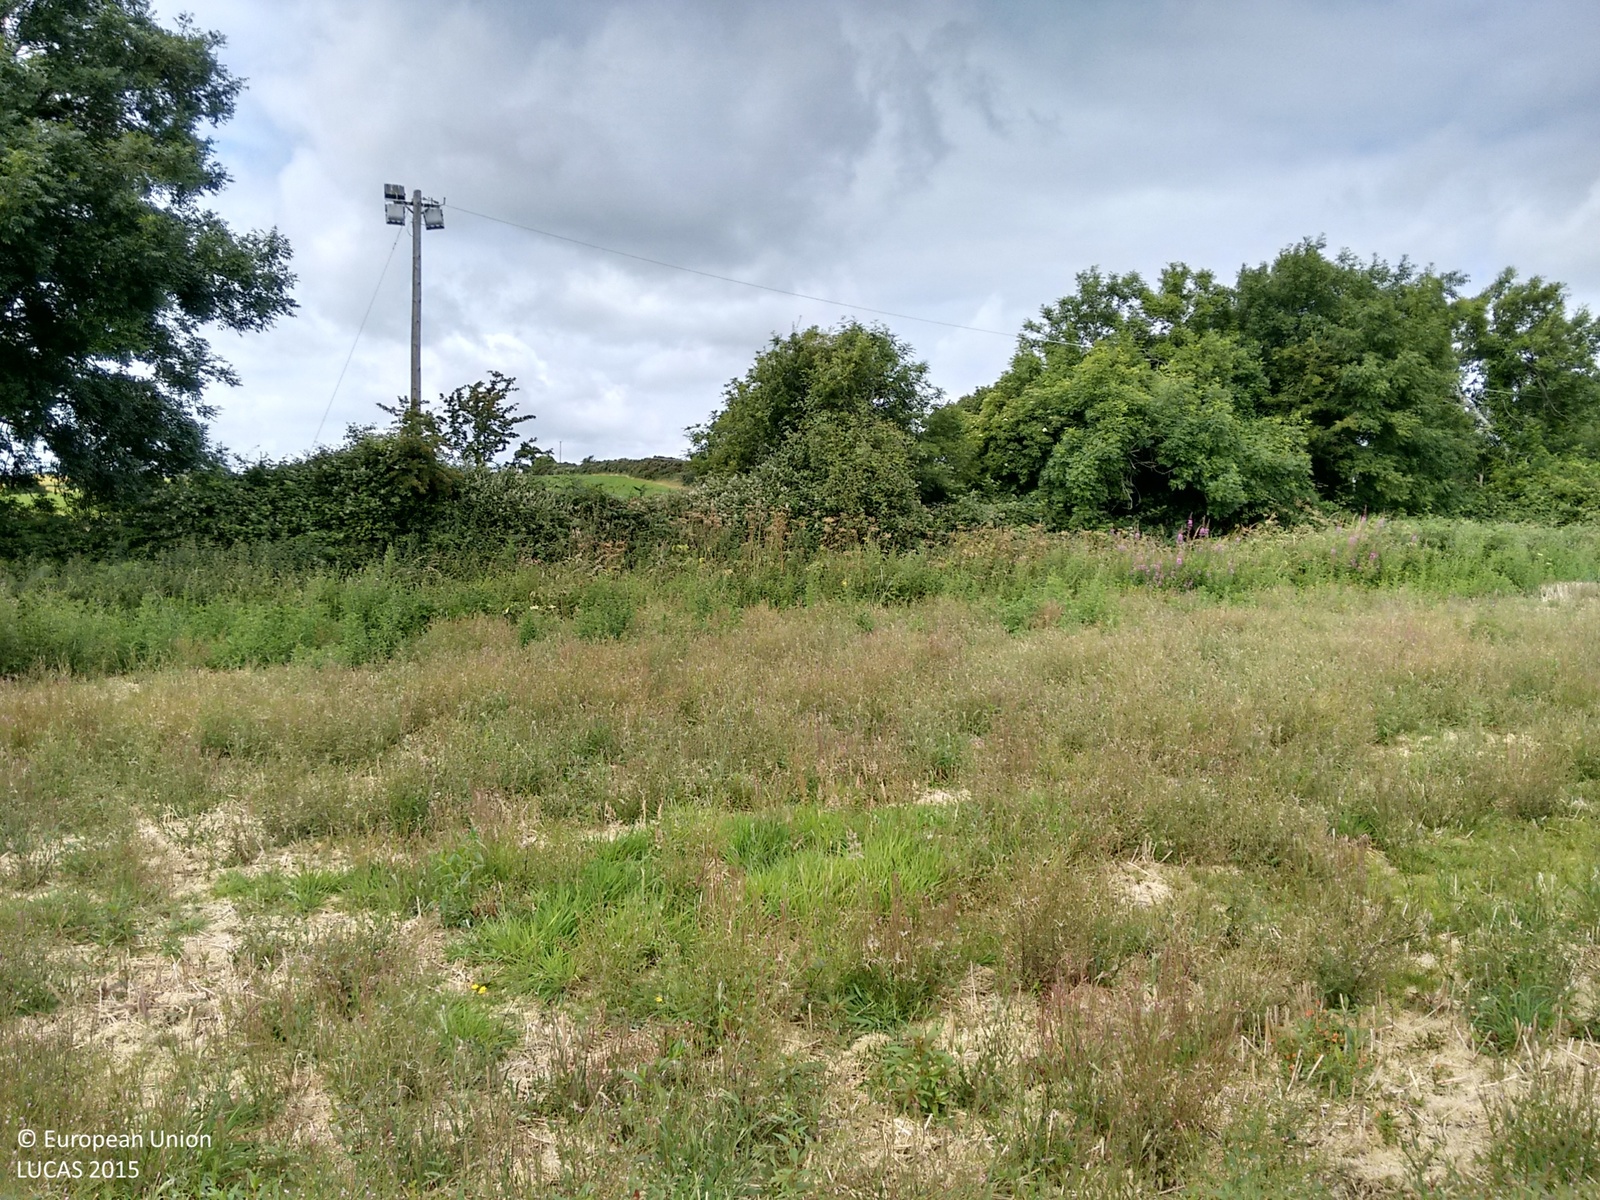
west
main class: Grassland
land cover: Spontaneously vegetated surfaces
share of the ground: > 75 %
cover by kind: herbaceous plants 80 %, unconsolidated bare surface 20 %
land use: Semi-natural and natural areas not in use
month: July
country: IE
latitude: 52.9797
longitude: -6.0660
